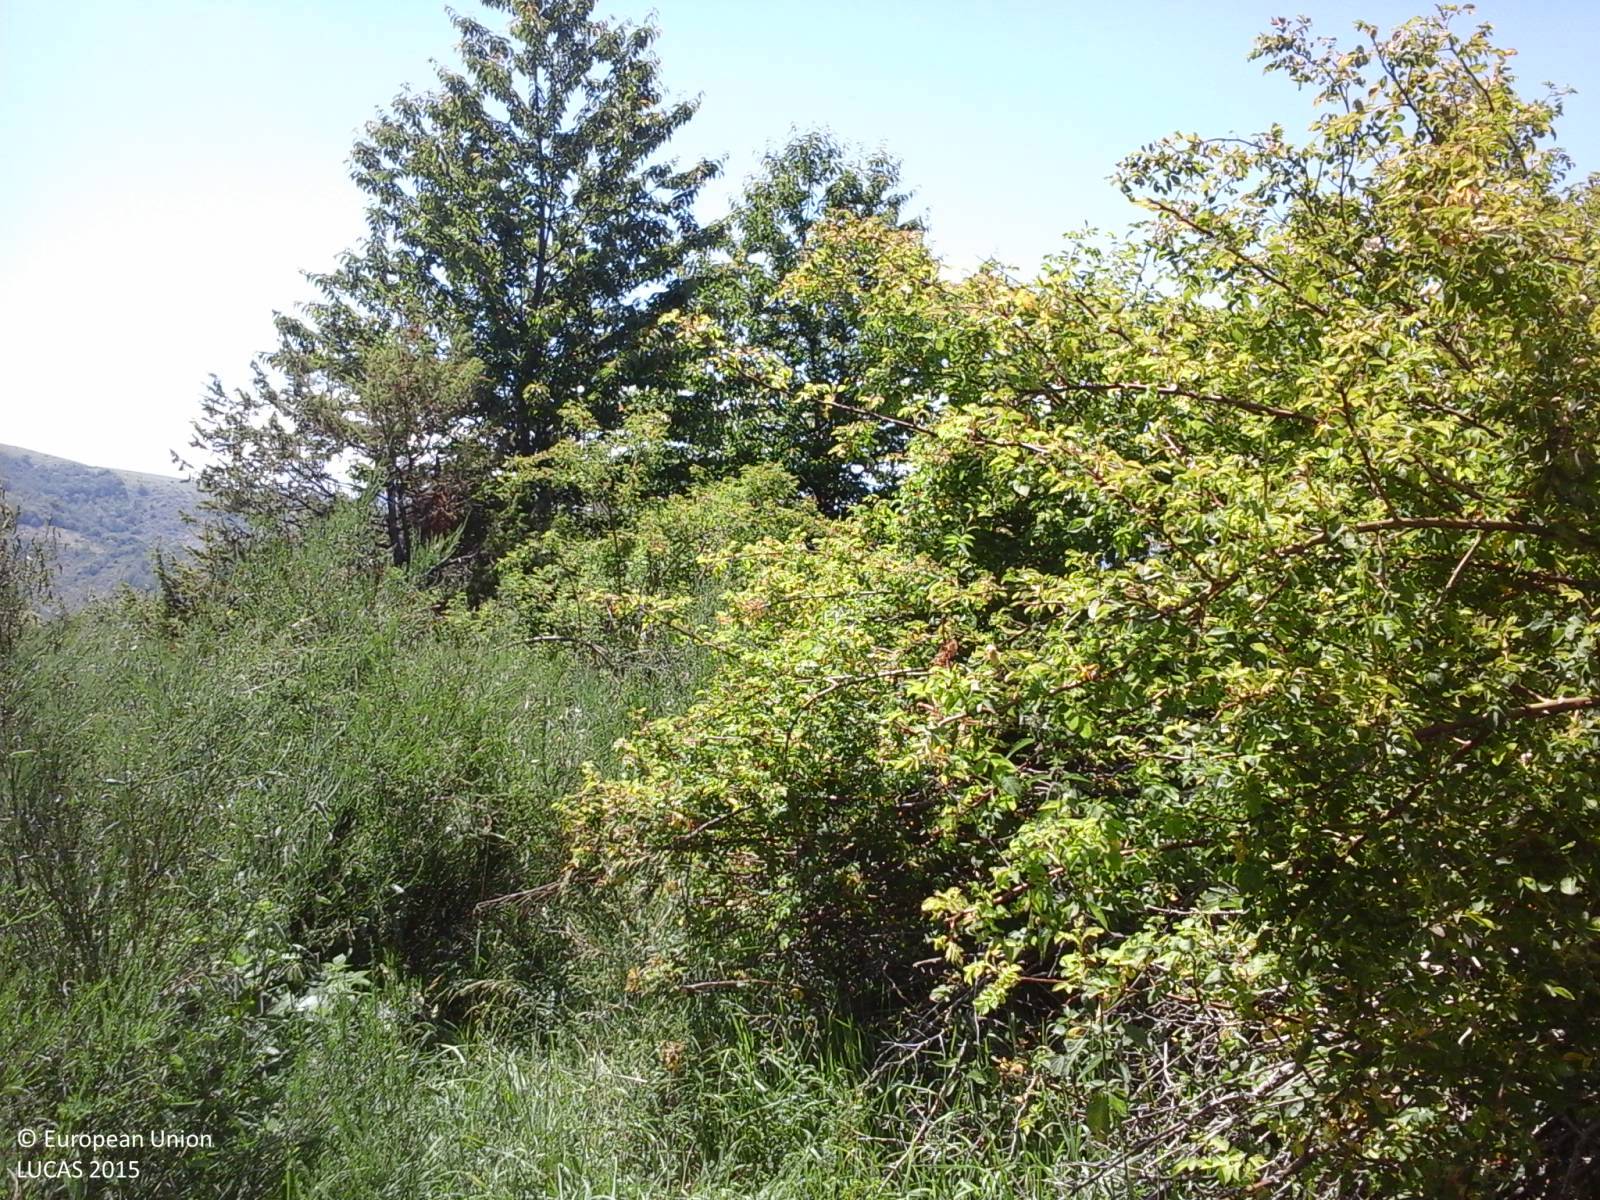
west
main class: Shrubland
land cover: Shrubland with sparse tree cover
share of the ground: > 75 %
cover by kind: shrubs 60 %, herbaceous plants 35 %, broadleaved forest trees 5 %
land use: Semi-natural and natural areas not in use
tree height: > 5 m
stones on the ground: < 10 %
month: July
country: IT
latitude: 42.5628
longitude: 13.3394
